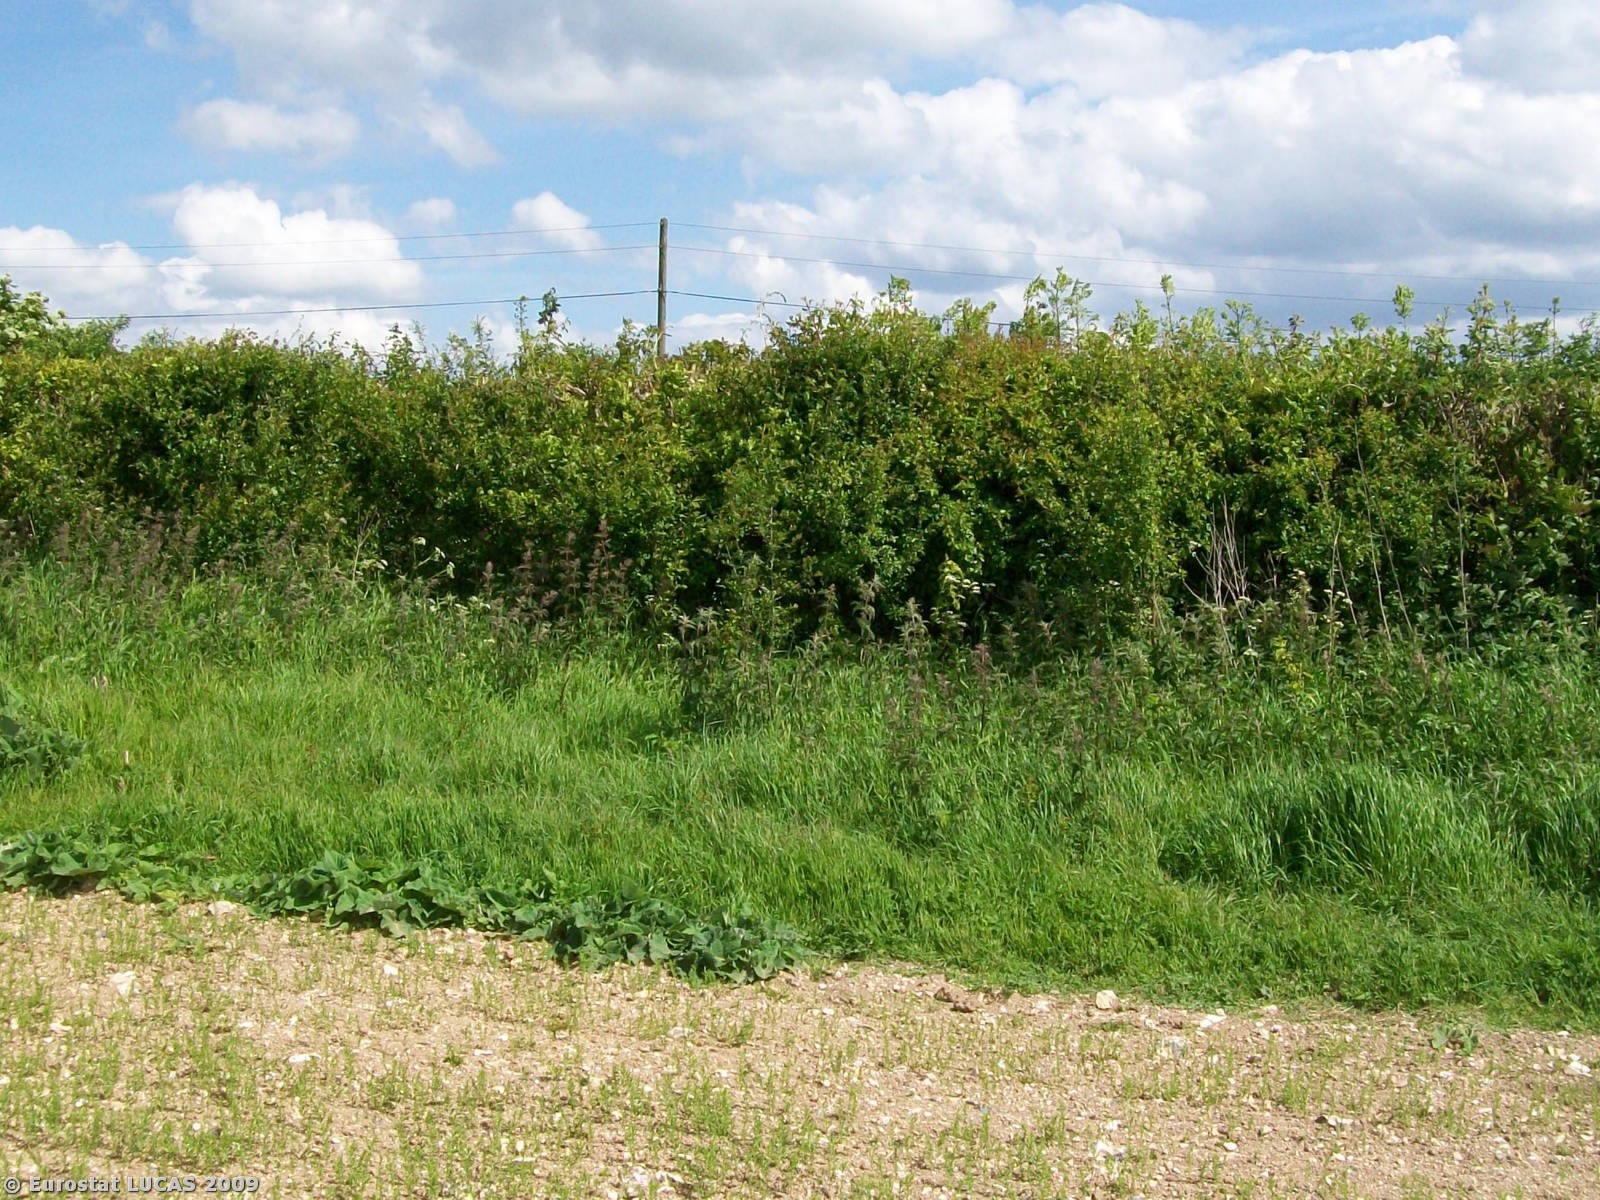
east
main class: Cropland
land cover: Other fibre and oleaginous crops
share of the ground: 50 - 75 %
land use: Agriculture (excluding fallow land and kitchen gardens)
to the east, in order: Other fibre and oleaginous crops; Grass margins; Managed hedges; Spontaneously vegetated surfaces; Tracks; Grass margins; Abandoned hedges; Spontaneously vegetated surfaces; Barley; Grass margins; Barley; Grass margins; Abandoned hedges; Arable land (only in case pi)
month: May
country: GB
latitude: 50.9183
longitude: -2.1082
